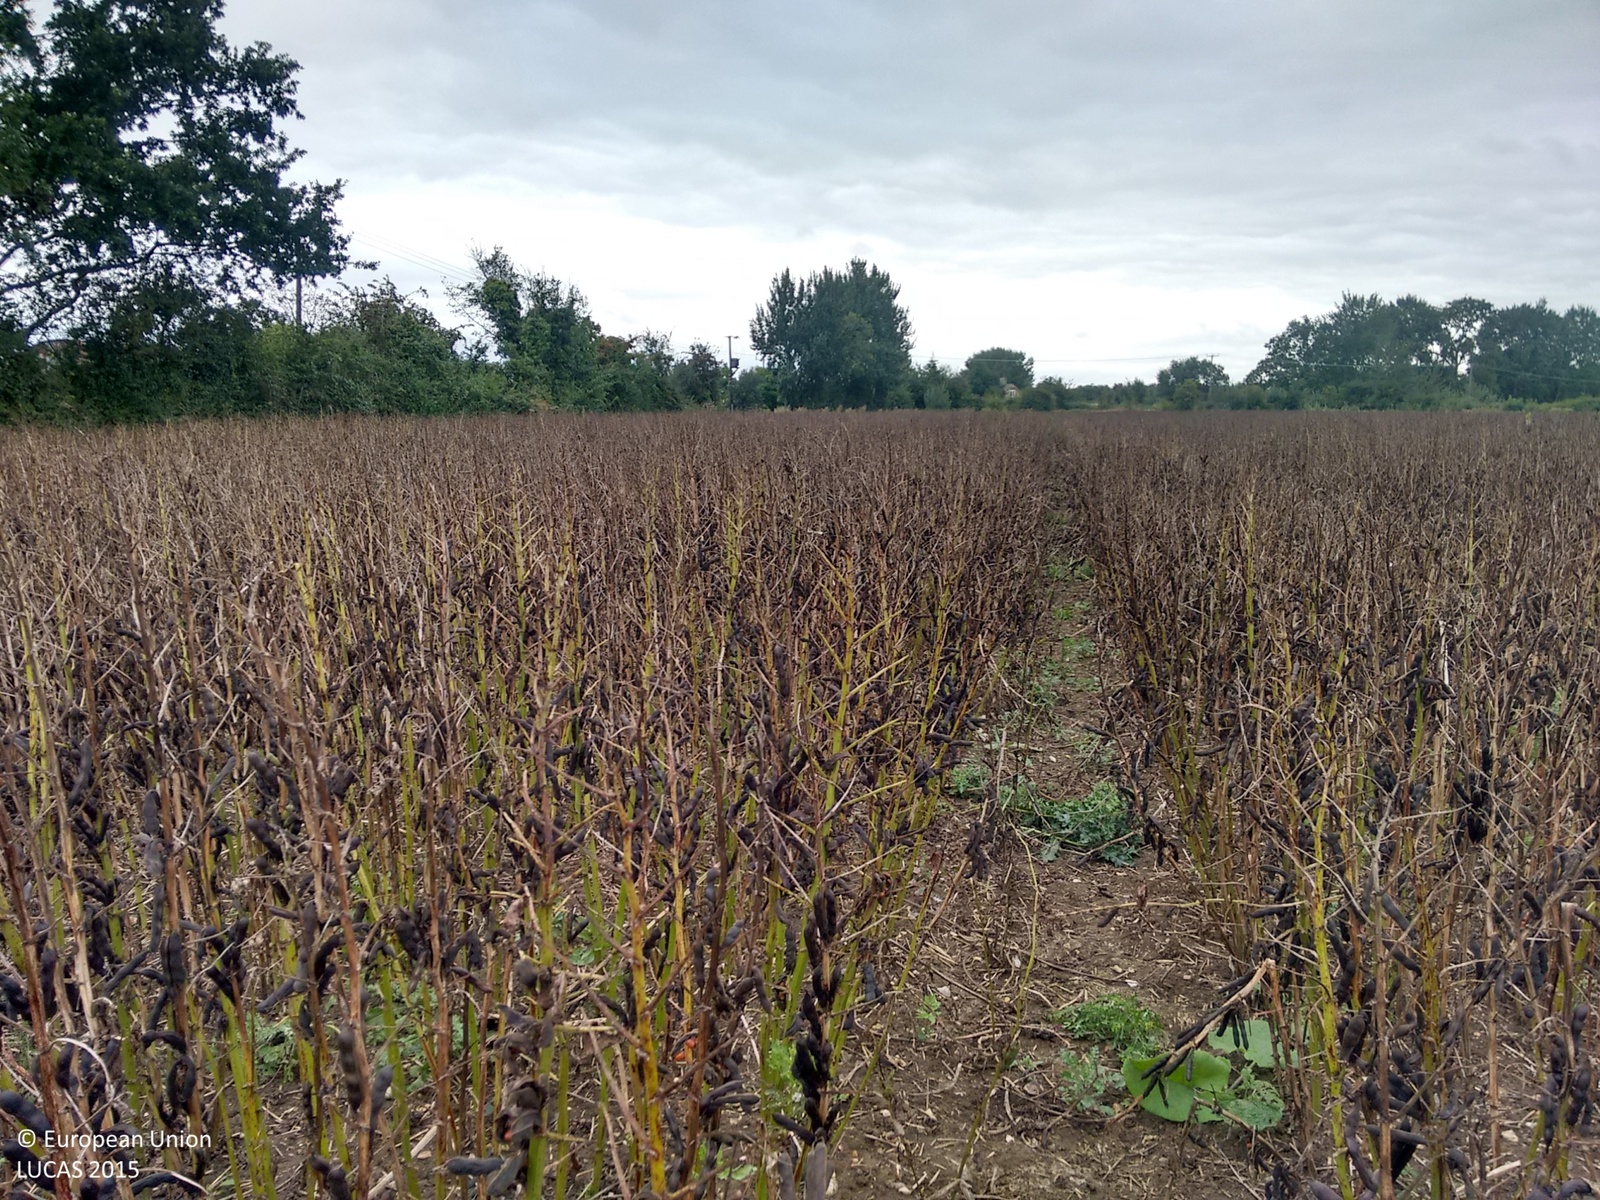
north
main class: Cropland
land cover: Dry pulses
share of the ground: > 75 %
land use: Agriculture (excluding fallow land and kitchen gardens)
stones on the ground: < 10 %
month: September
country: GB
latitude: 52.3260
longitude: 0.3307
